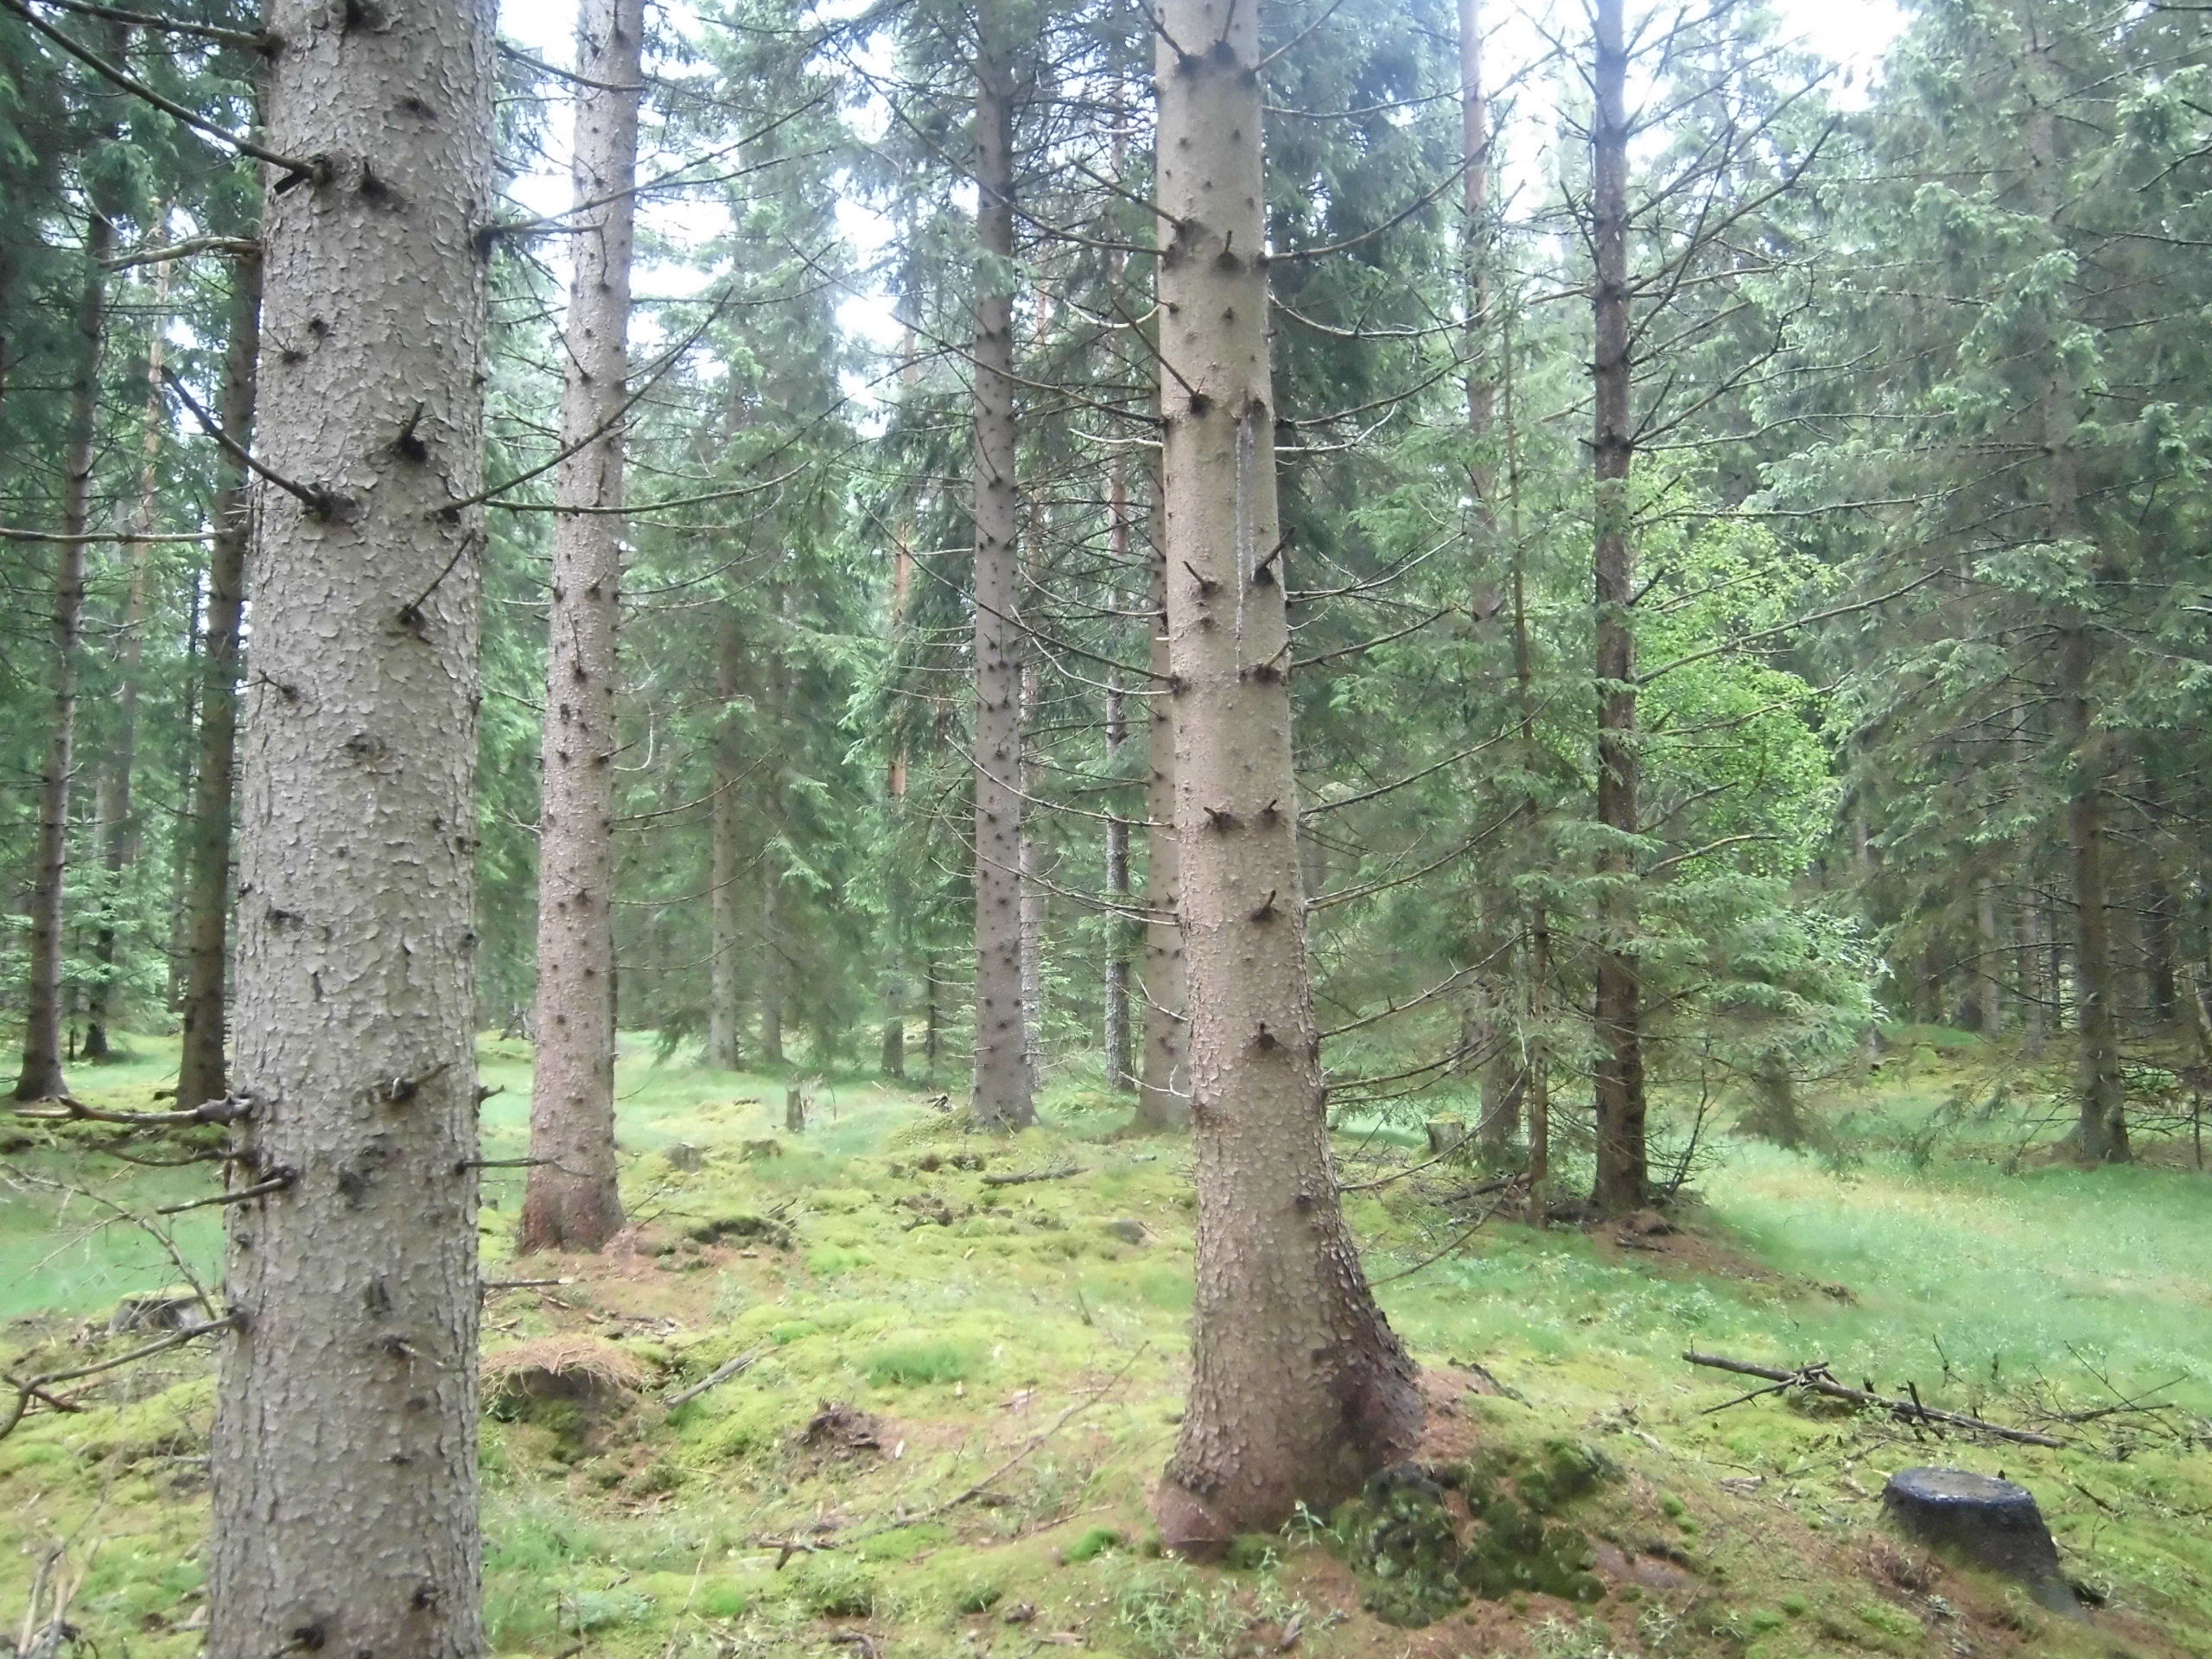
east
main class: Woodland
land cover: Spruce dominated coniferous woodland
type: boreal forest
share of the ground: 50 - 75 %
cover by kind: coniferous forest trees 60 %, lichens and mosses 20 %, herbaceous plants 10 %, broadleaved forest trees 5 %, shrubs 5 %
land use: Forestry
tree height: > 5 m
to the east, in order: Spruce dominated coniferous woodland; Ditches and canals; Spruce dominated coniferous woodland; Spruce dominated mixed woodland; Spruce dominated coniferous woodland
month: July
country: SE
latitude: 57.1236
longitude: 15.2994
